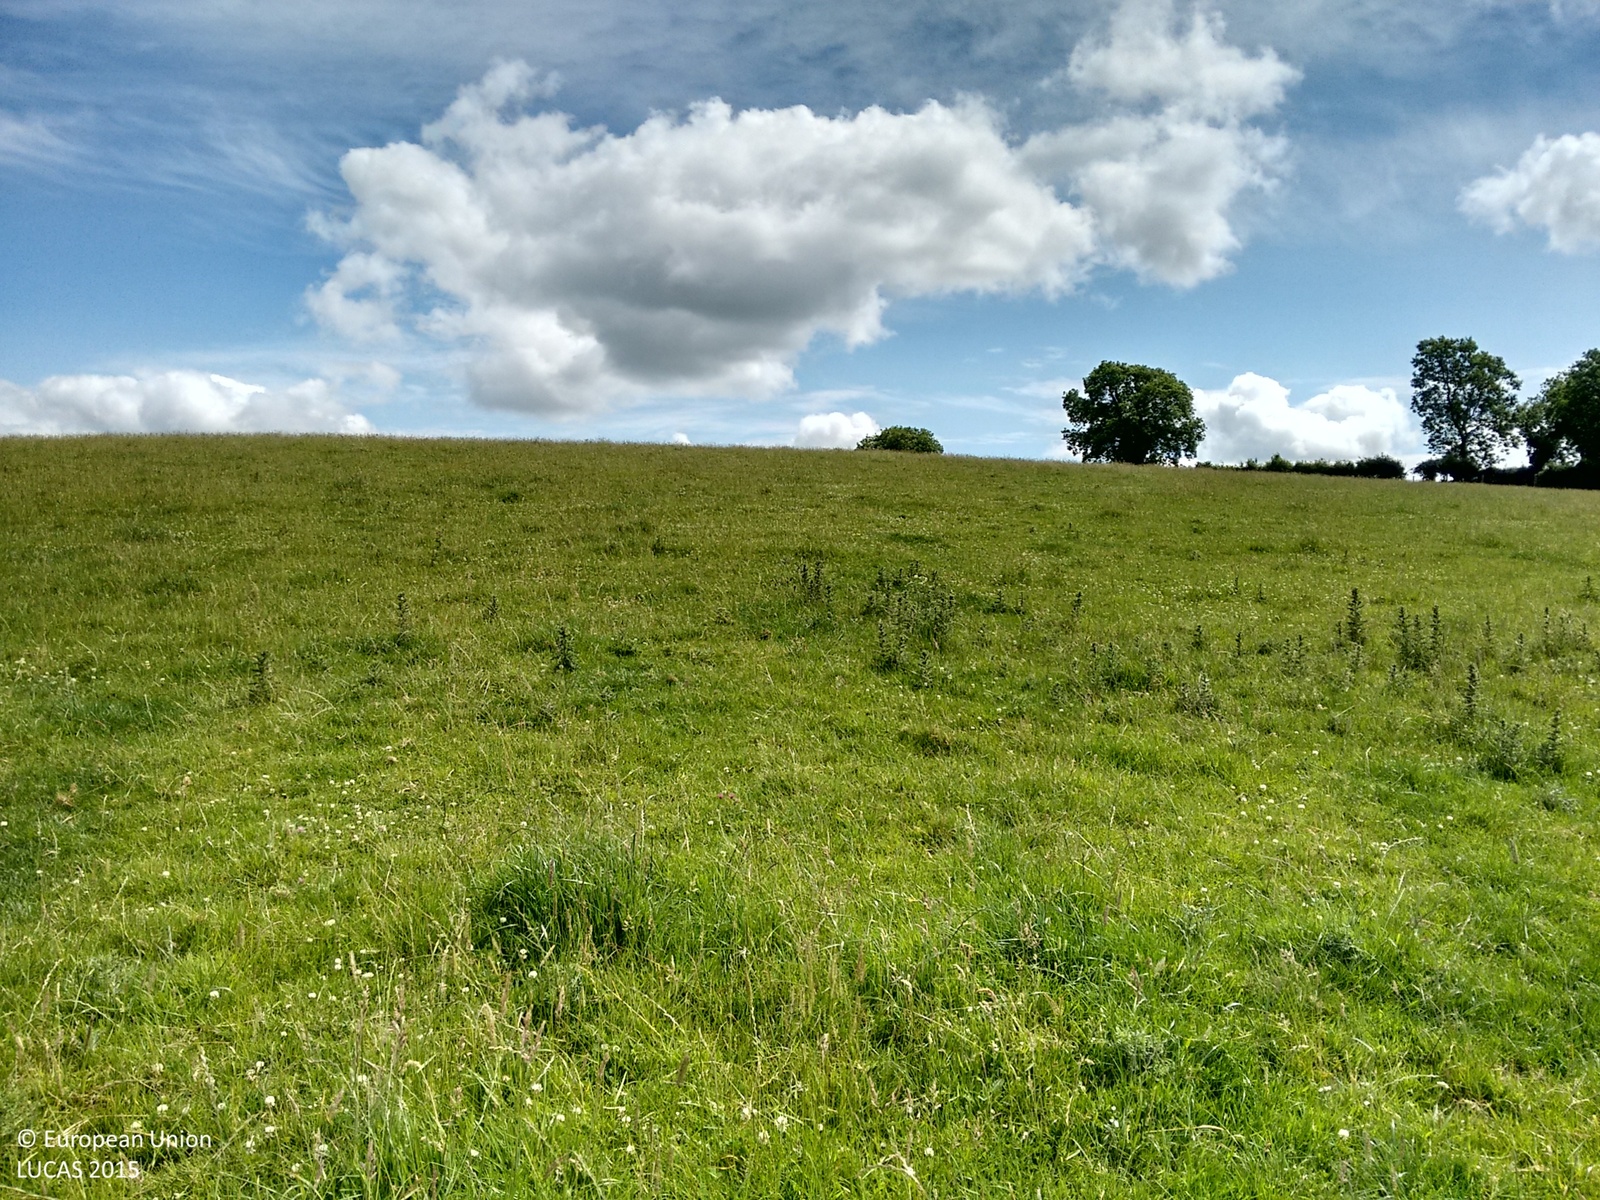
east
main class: Grassland
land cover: Grassland without tree/shrub cover
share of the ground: > 75 %
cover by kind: herbaceous plants 100 %
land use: Agriculture (excluding fallow land and kitchen gardens)
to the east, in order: Grassland without tree/shrub cover; Managed hedges; Grassland without tree/shrub cover
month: July
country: IE
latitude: 53.8852
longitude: -6.6997
